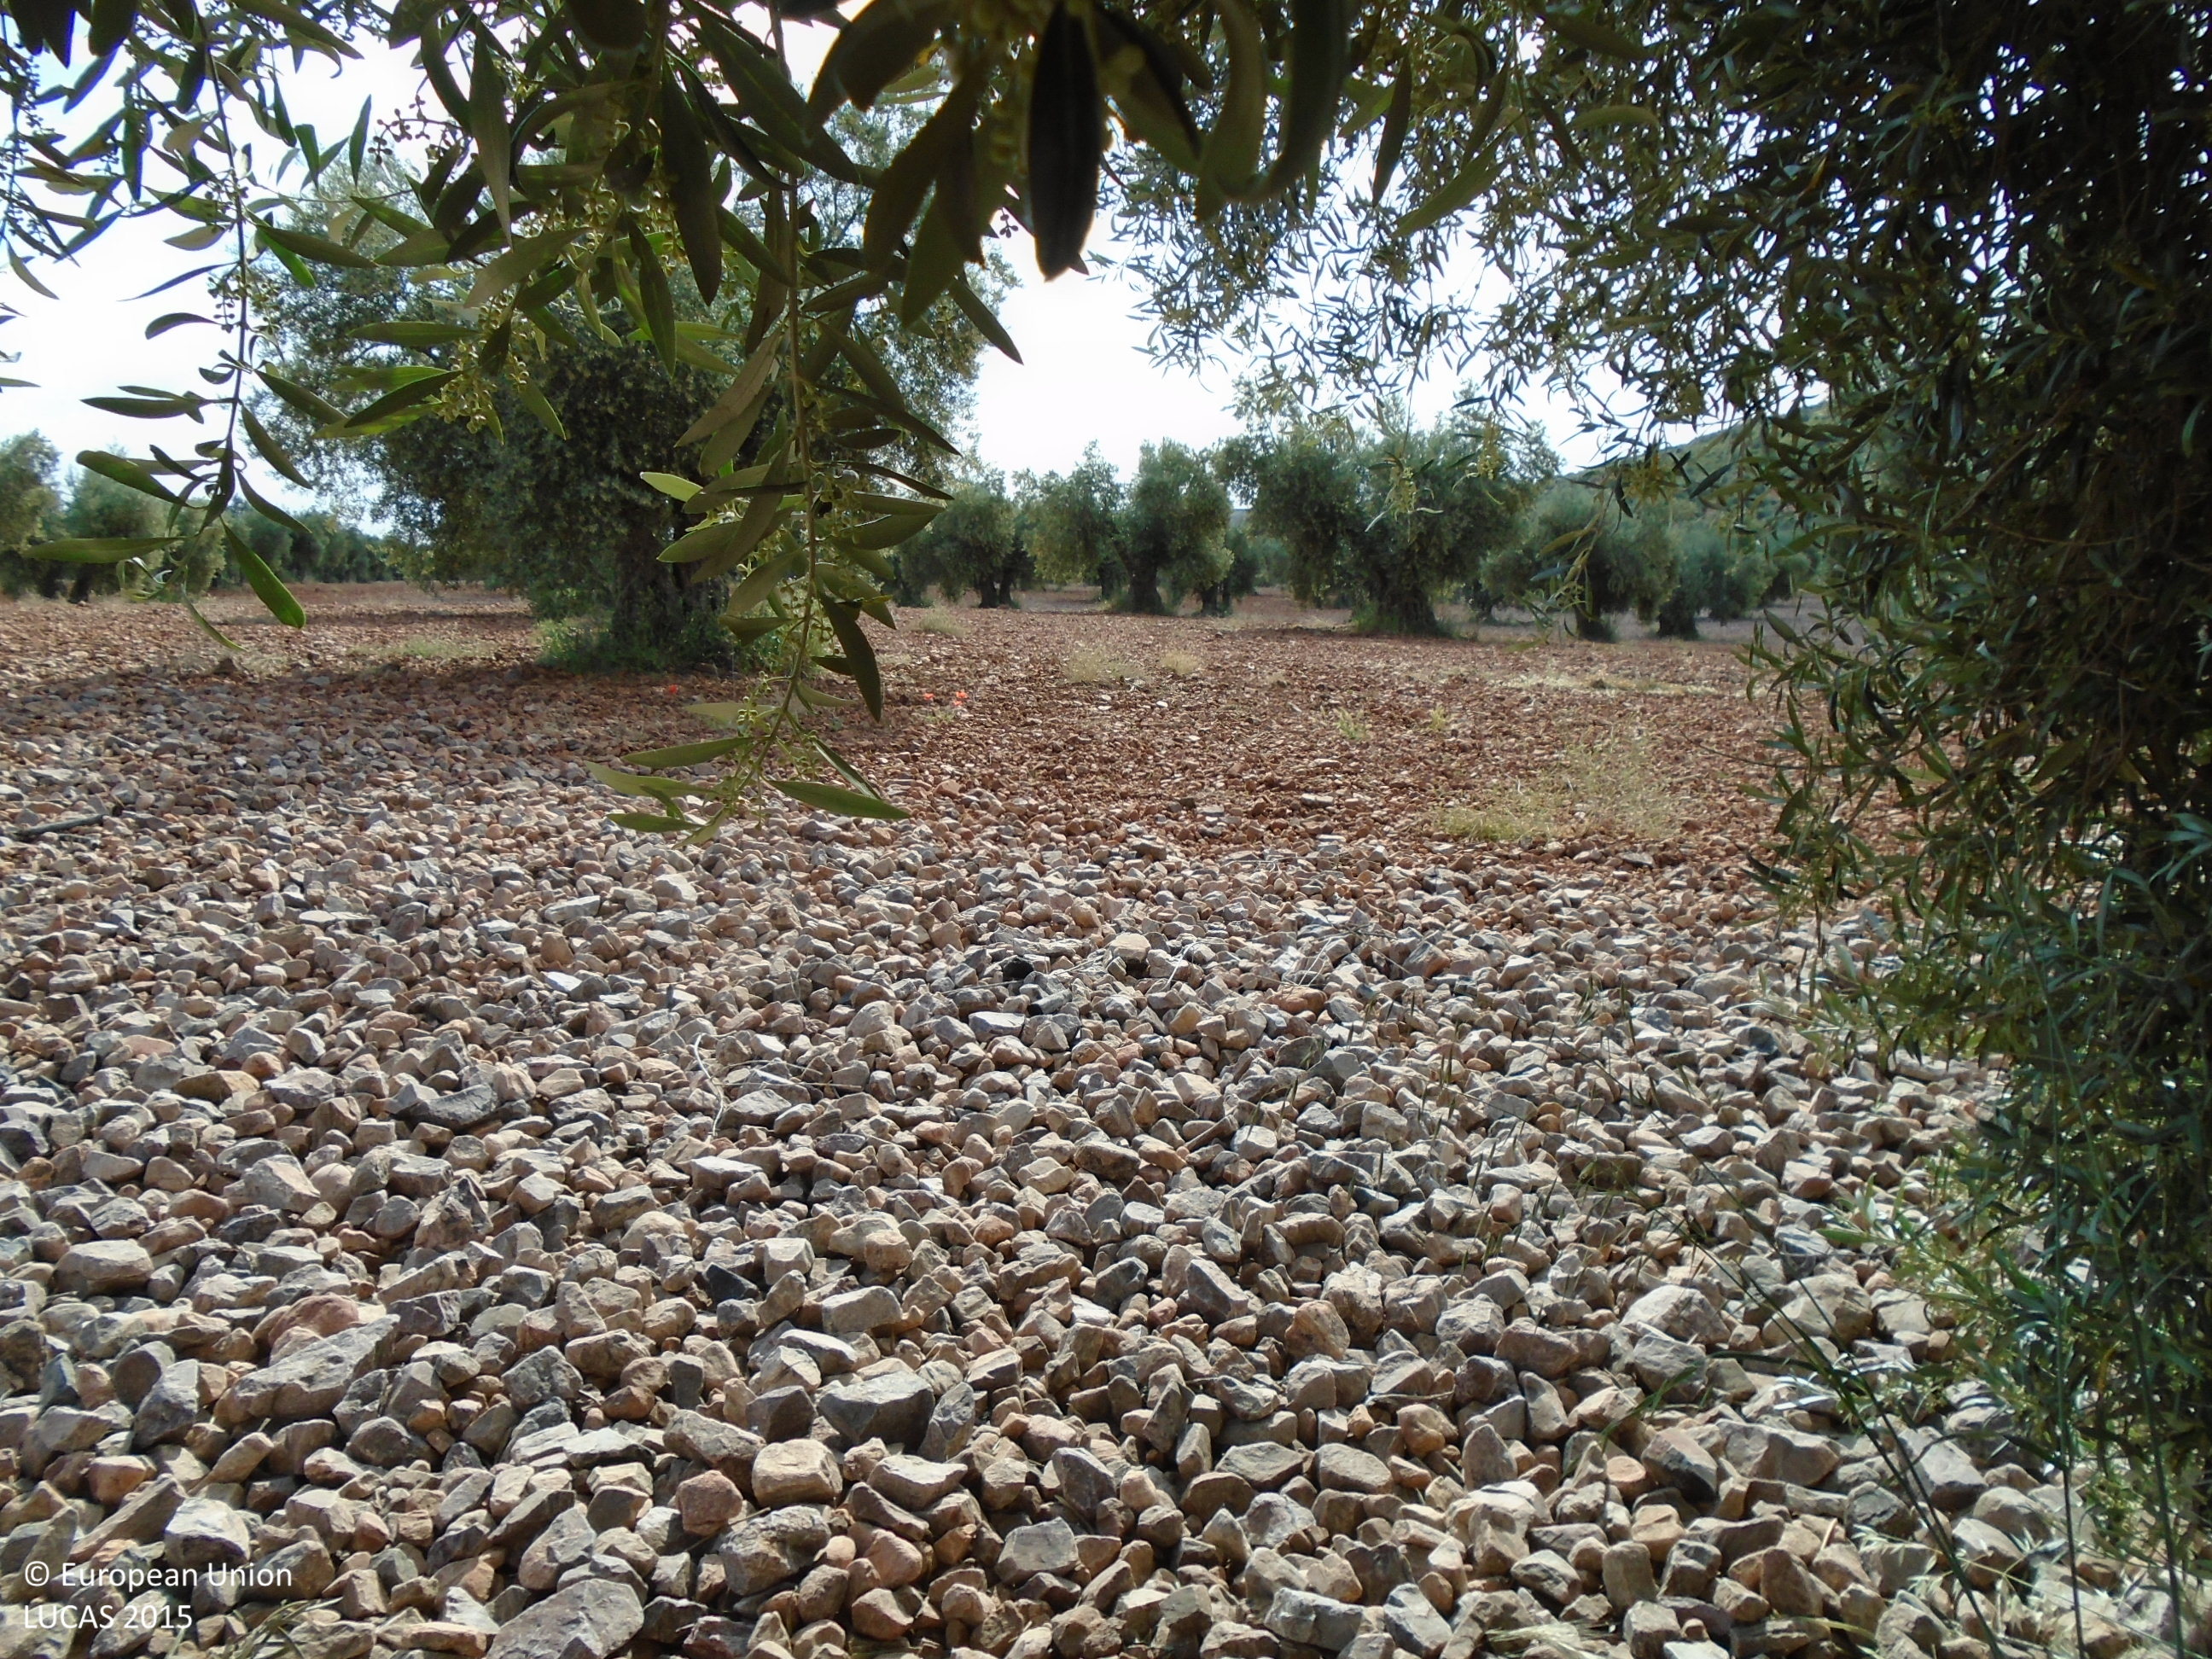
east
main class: Cropland
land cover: Olive groves
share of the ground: 10 - 25 %
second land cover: Other bare soil
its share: > 75 %
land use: Agriculture (excluding fallow land and kitchen gardens)
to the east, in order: Olive groves; Other bare soil
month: May
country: ES
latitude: 39.5900
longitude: -3.7317
